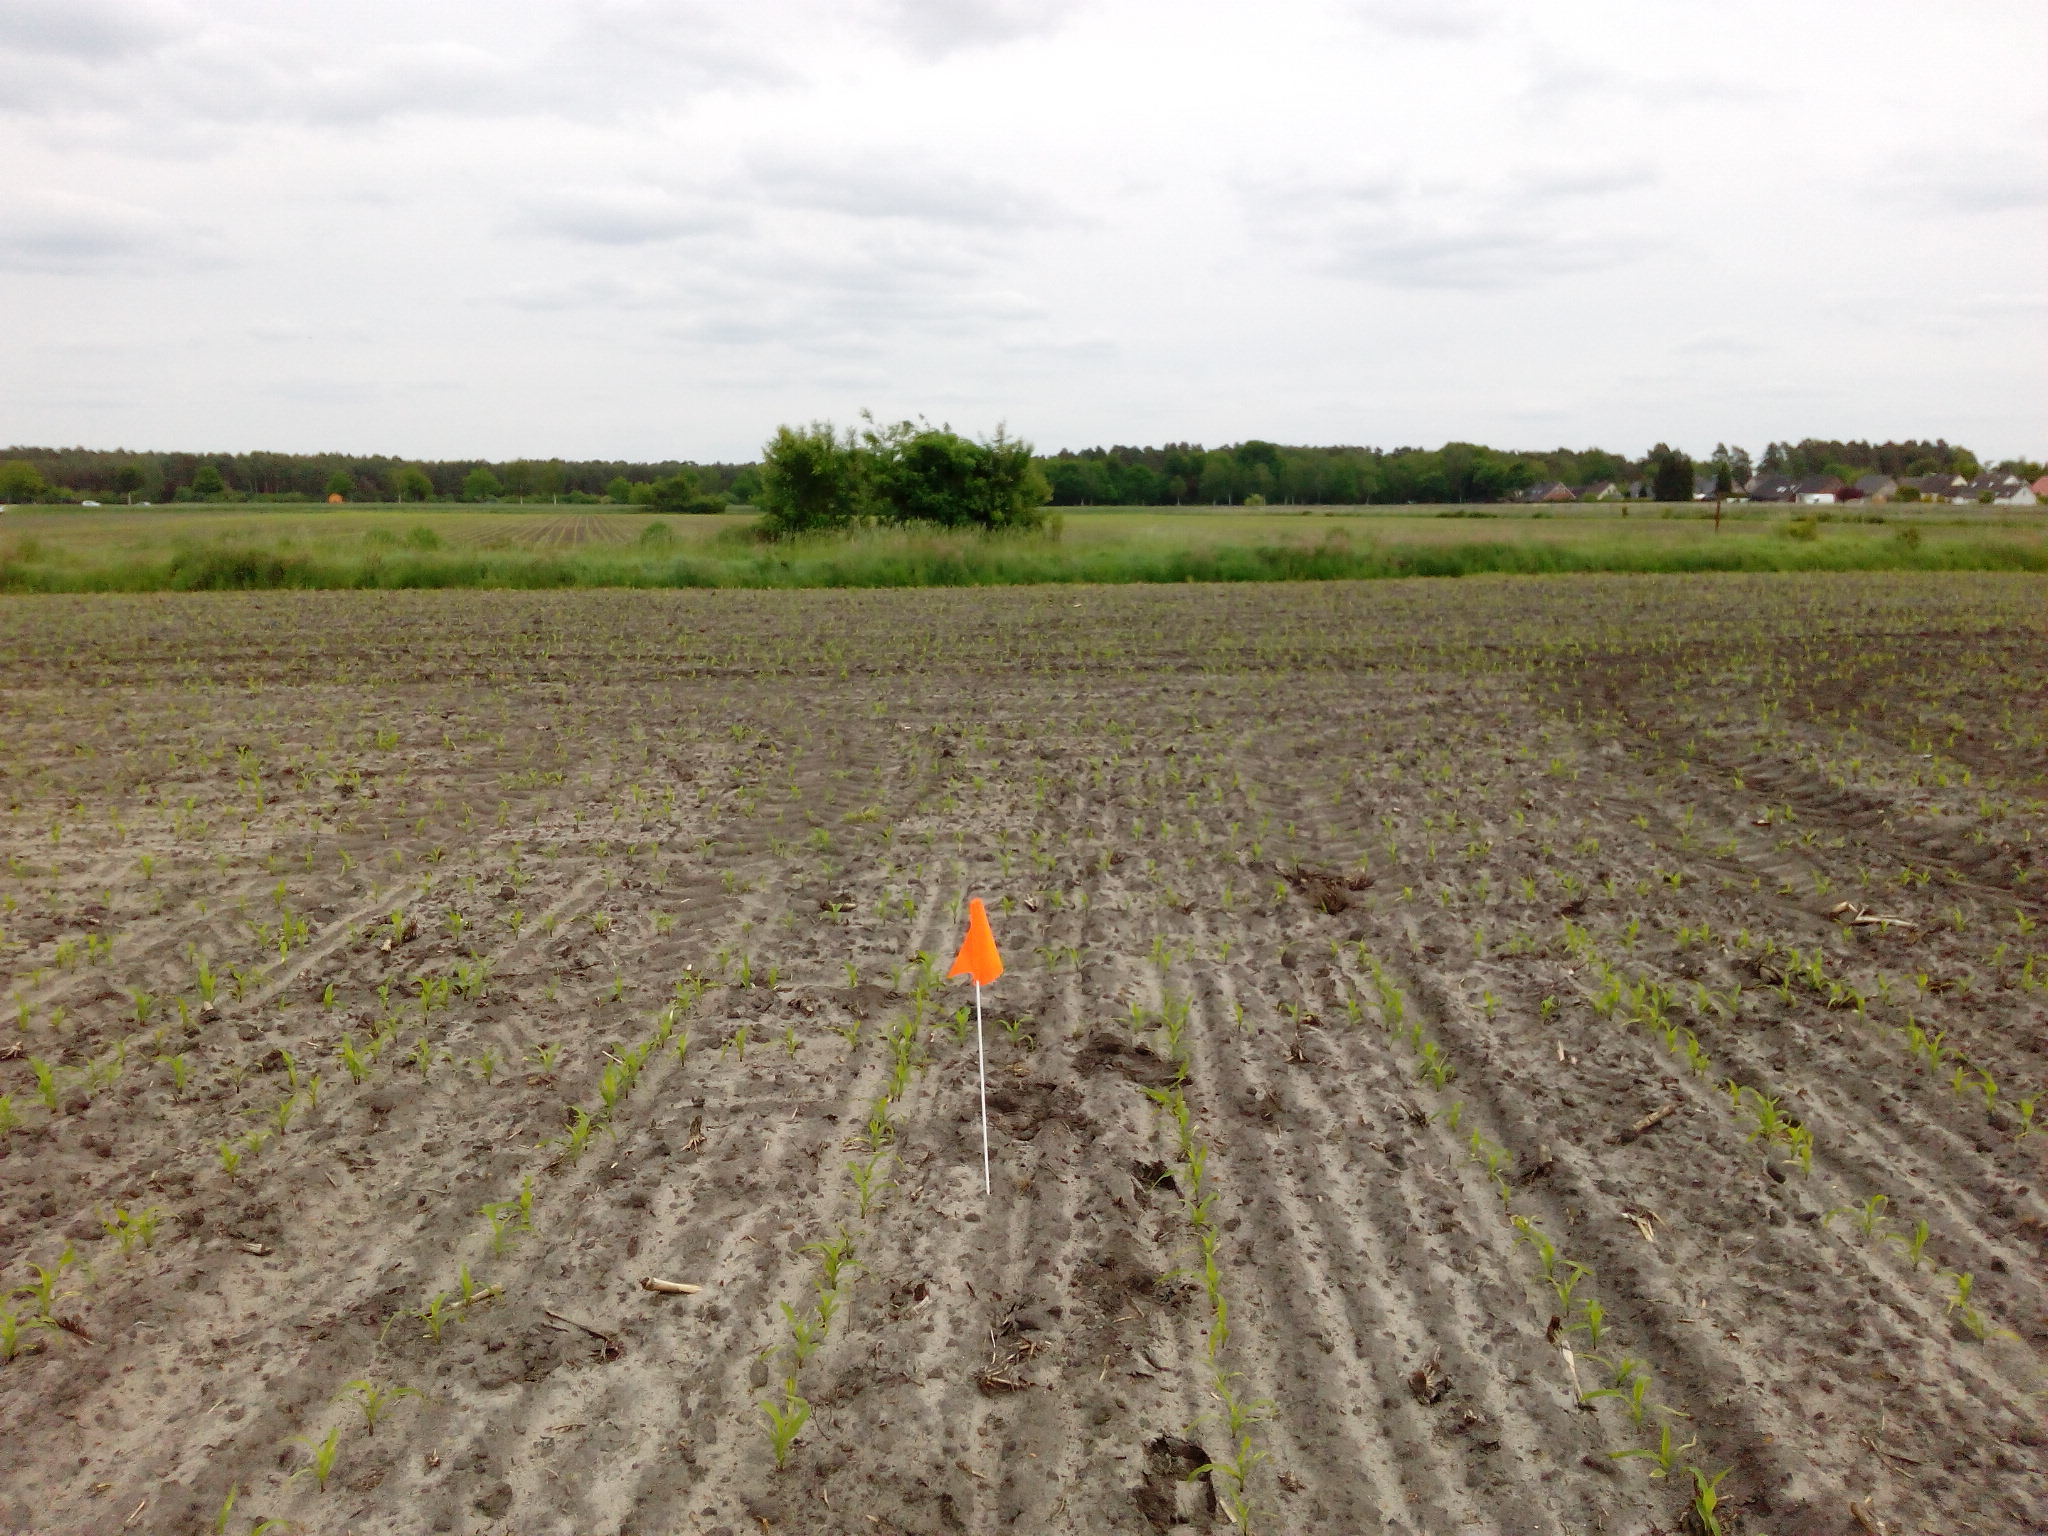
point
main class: Cropland
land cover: Maize
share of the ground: < 10 %
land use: Agriculture (excluding fallow land and kitchen gardens)
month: June
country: DE
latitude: 52.6470
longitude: 9.9261
